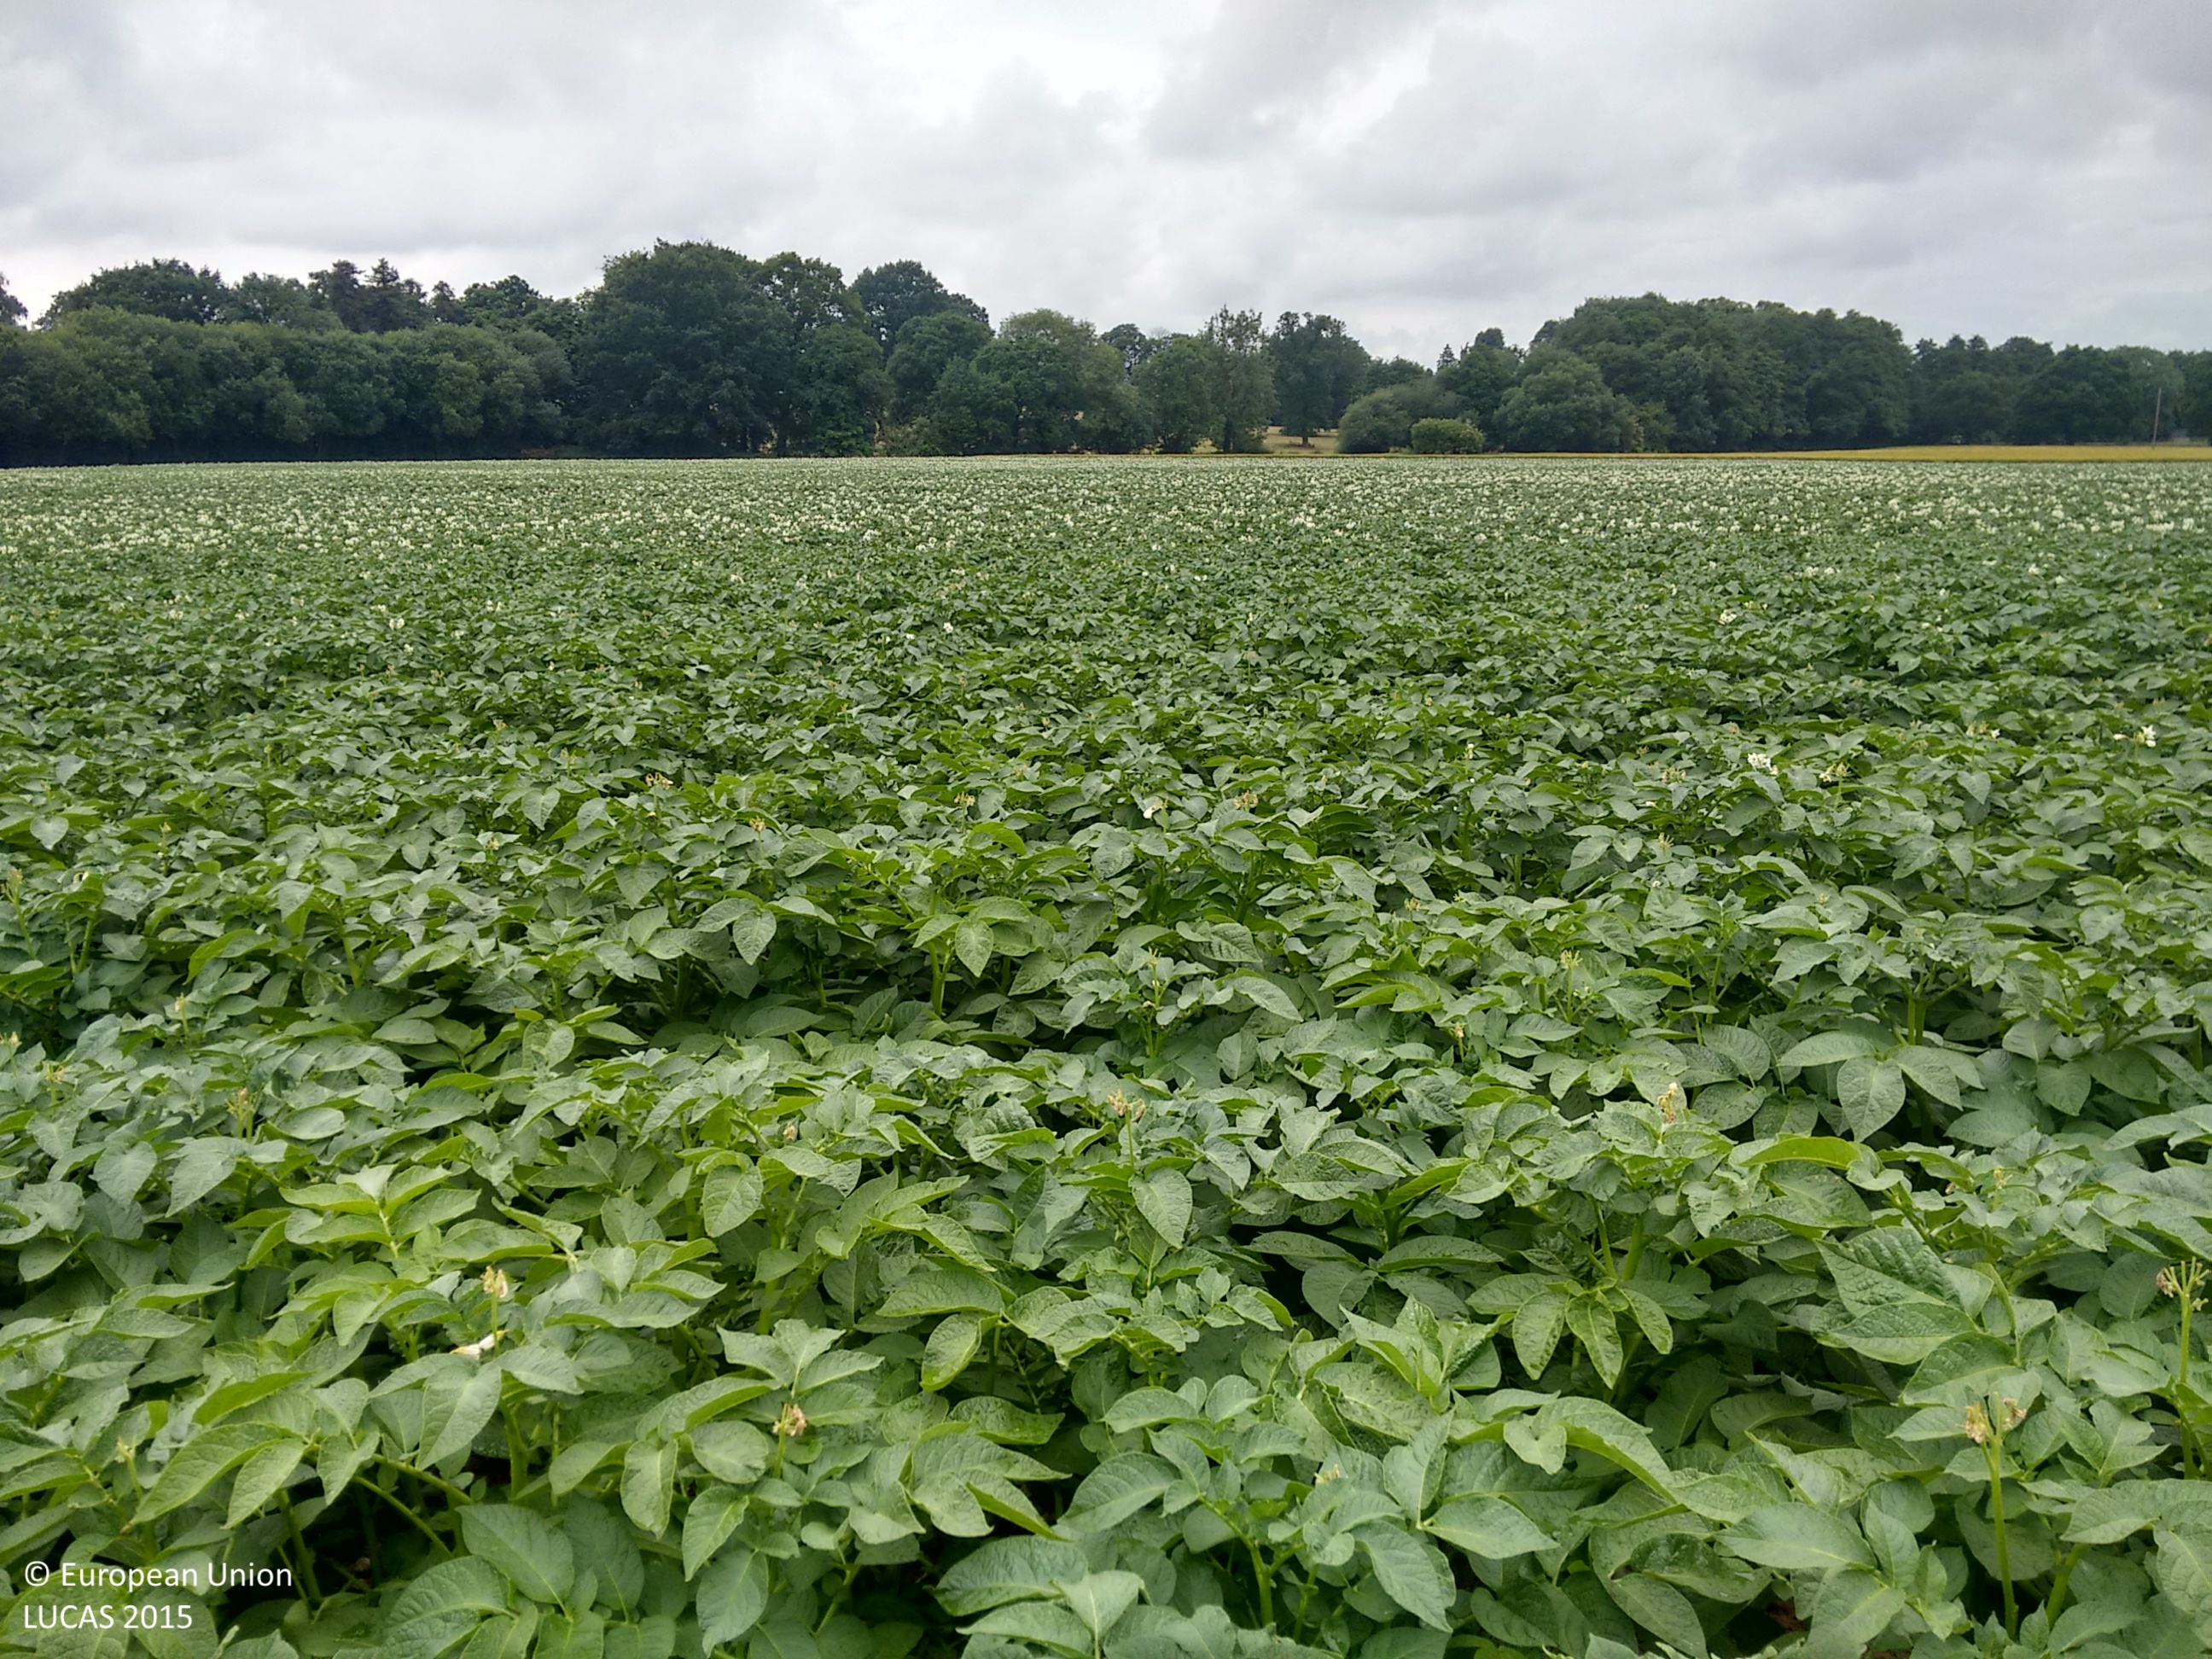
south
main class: Cropland
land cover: Potatoes
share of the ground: > 75 %
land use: Agriculture (excluding fallow land and kitchen gardens)
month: July
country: GB
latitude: 52.2334
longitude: -2.2297
